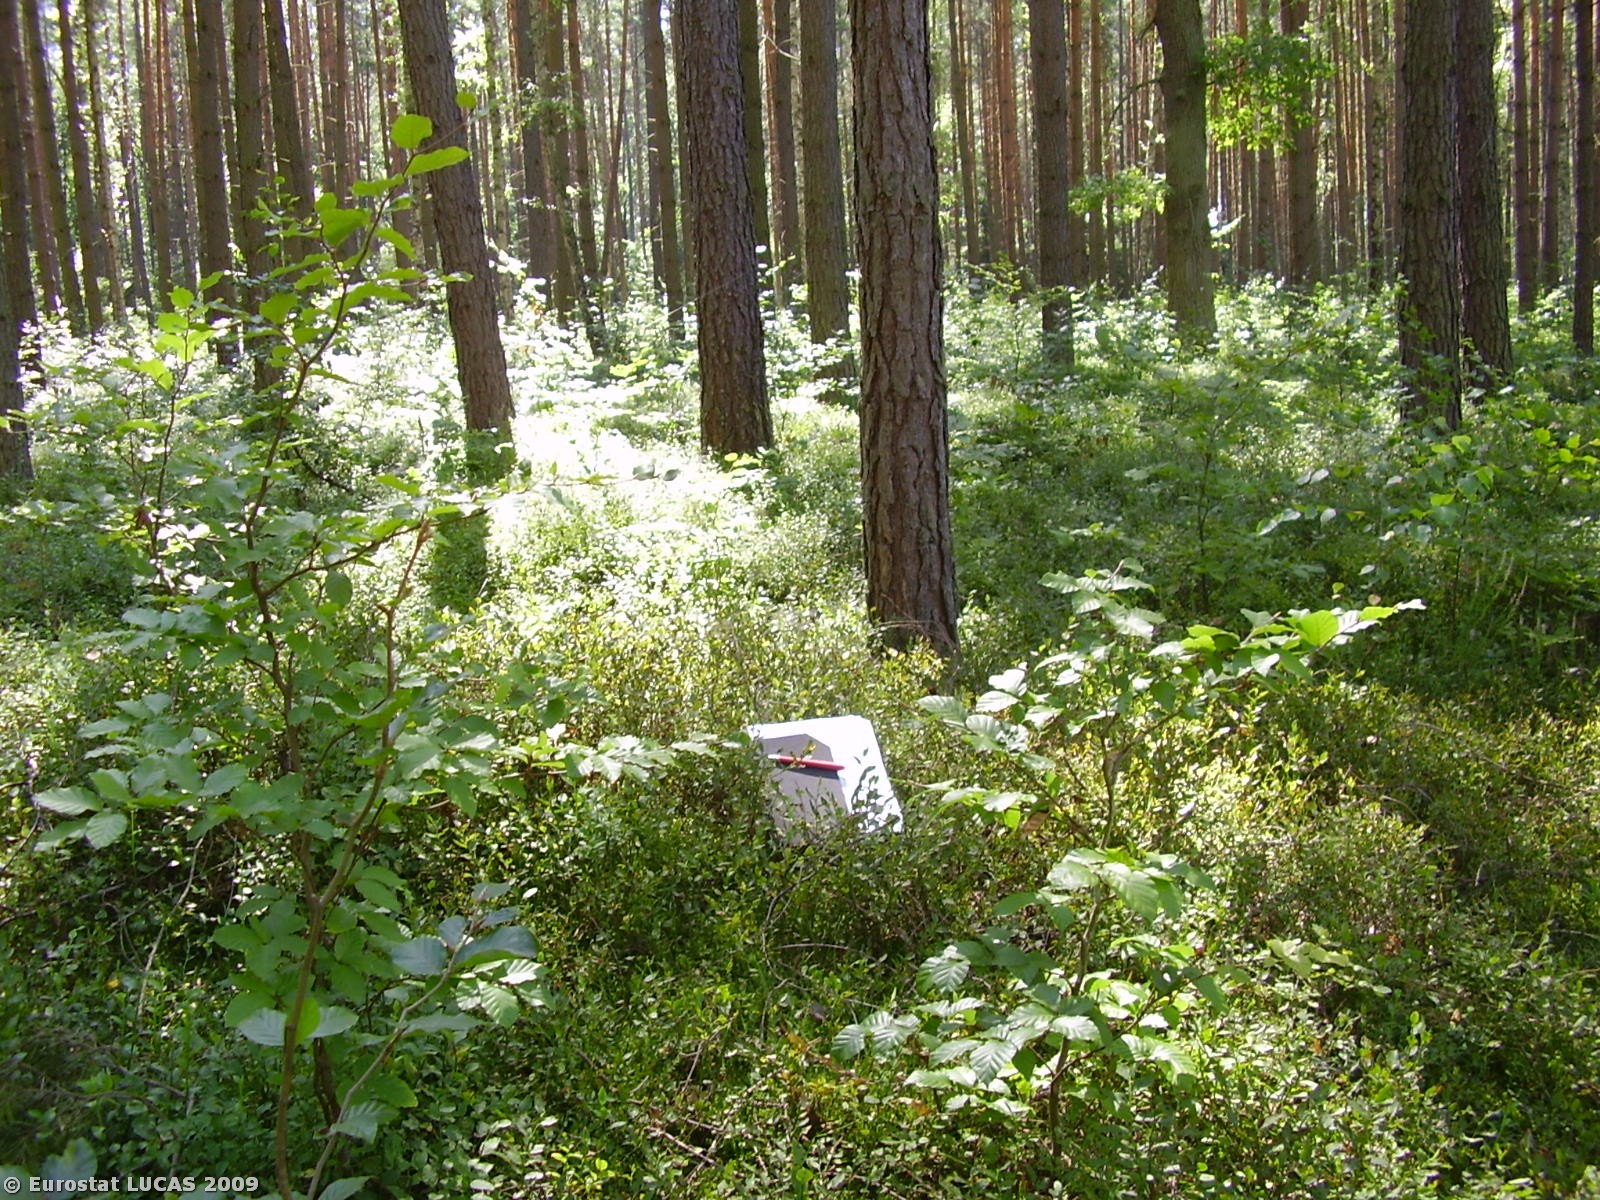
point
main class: Woodland
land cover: Mixed woodland
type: hemiboreal forest and nemoral coniferous forest and mixed broadleaved-coniferous forest
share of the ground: > 75 %
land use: Forestry
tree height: > 5 m
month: August
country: PL
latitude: 51.3749
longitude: 17.3242
